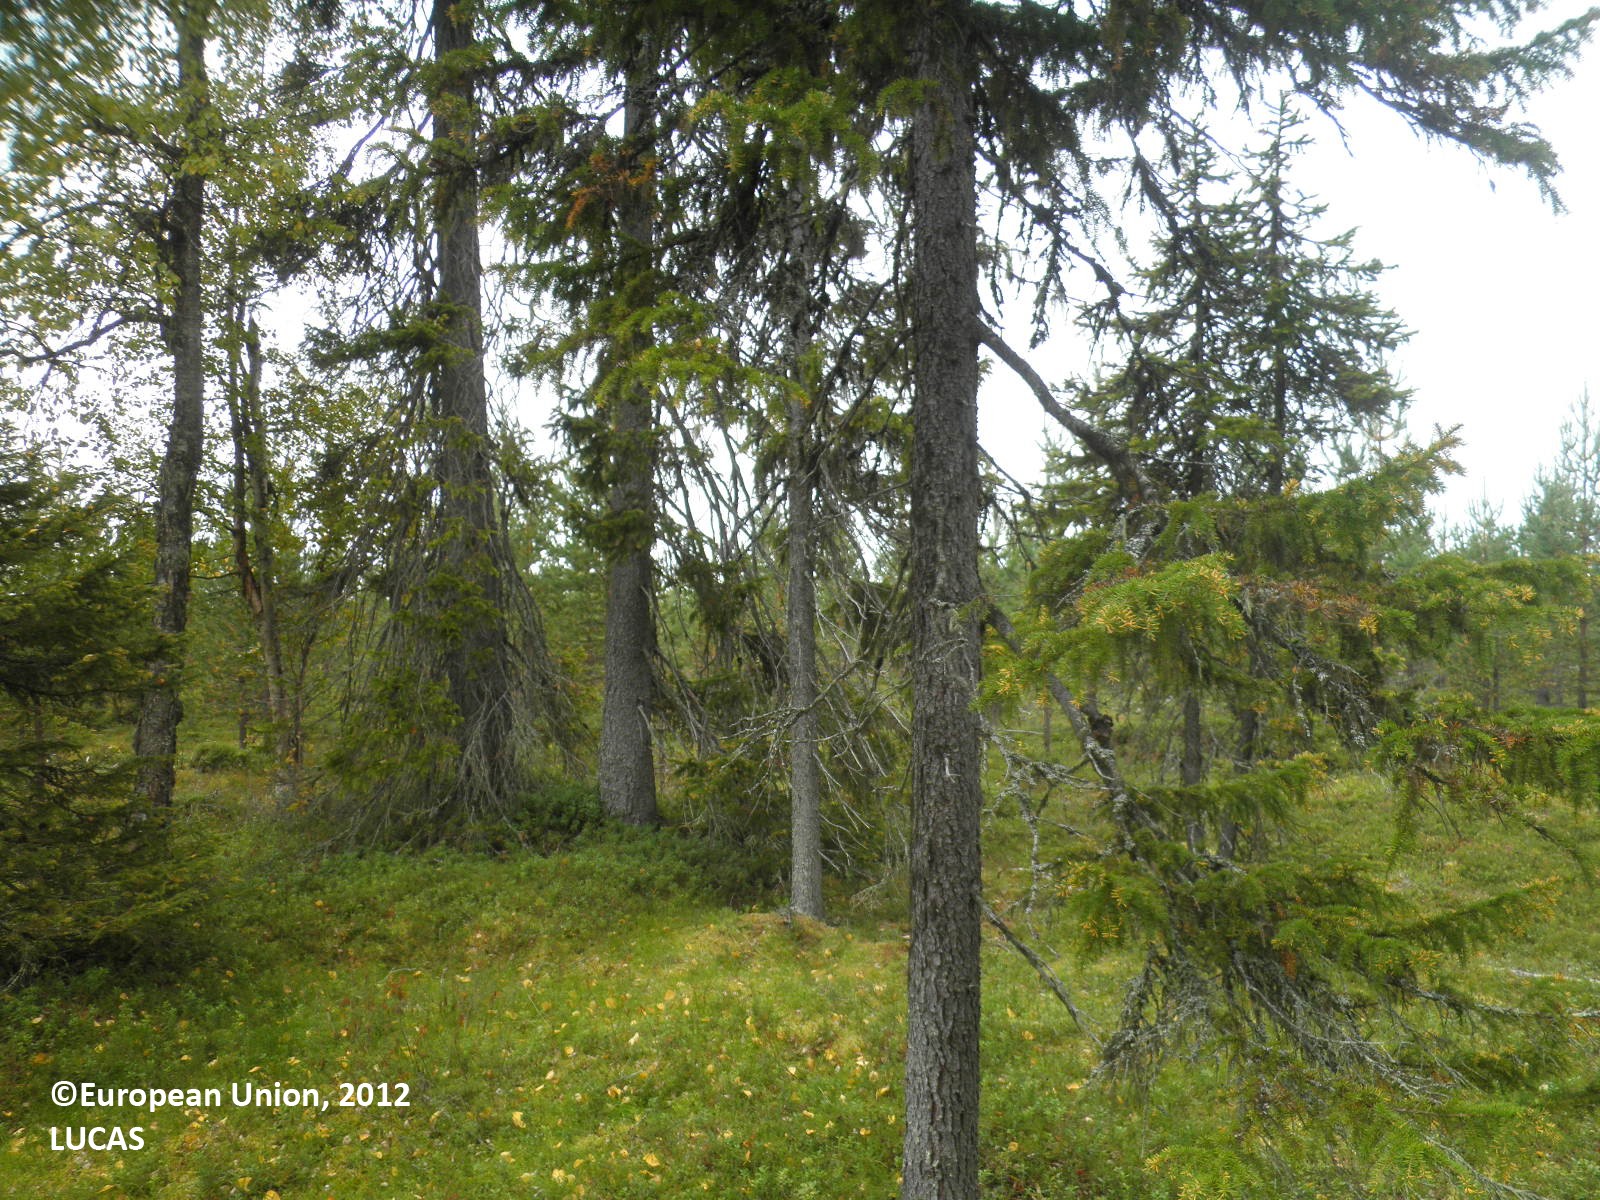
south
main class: Woodland
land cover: Spruce dominated mixed woodland
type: boreal forest
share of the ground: 50 - 75 %
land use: Forestry
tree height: > 5 m
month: August
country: FI
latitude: 67.5787
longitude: 27.9900
